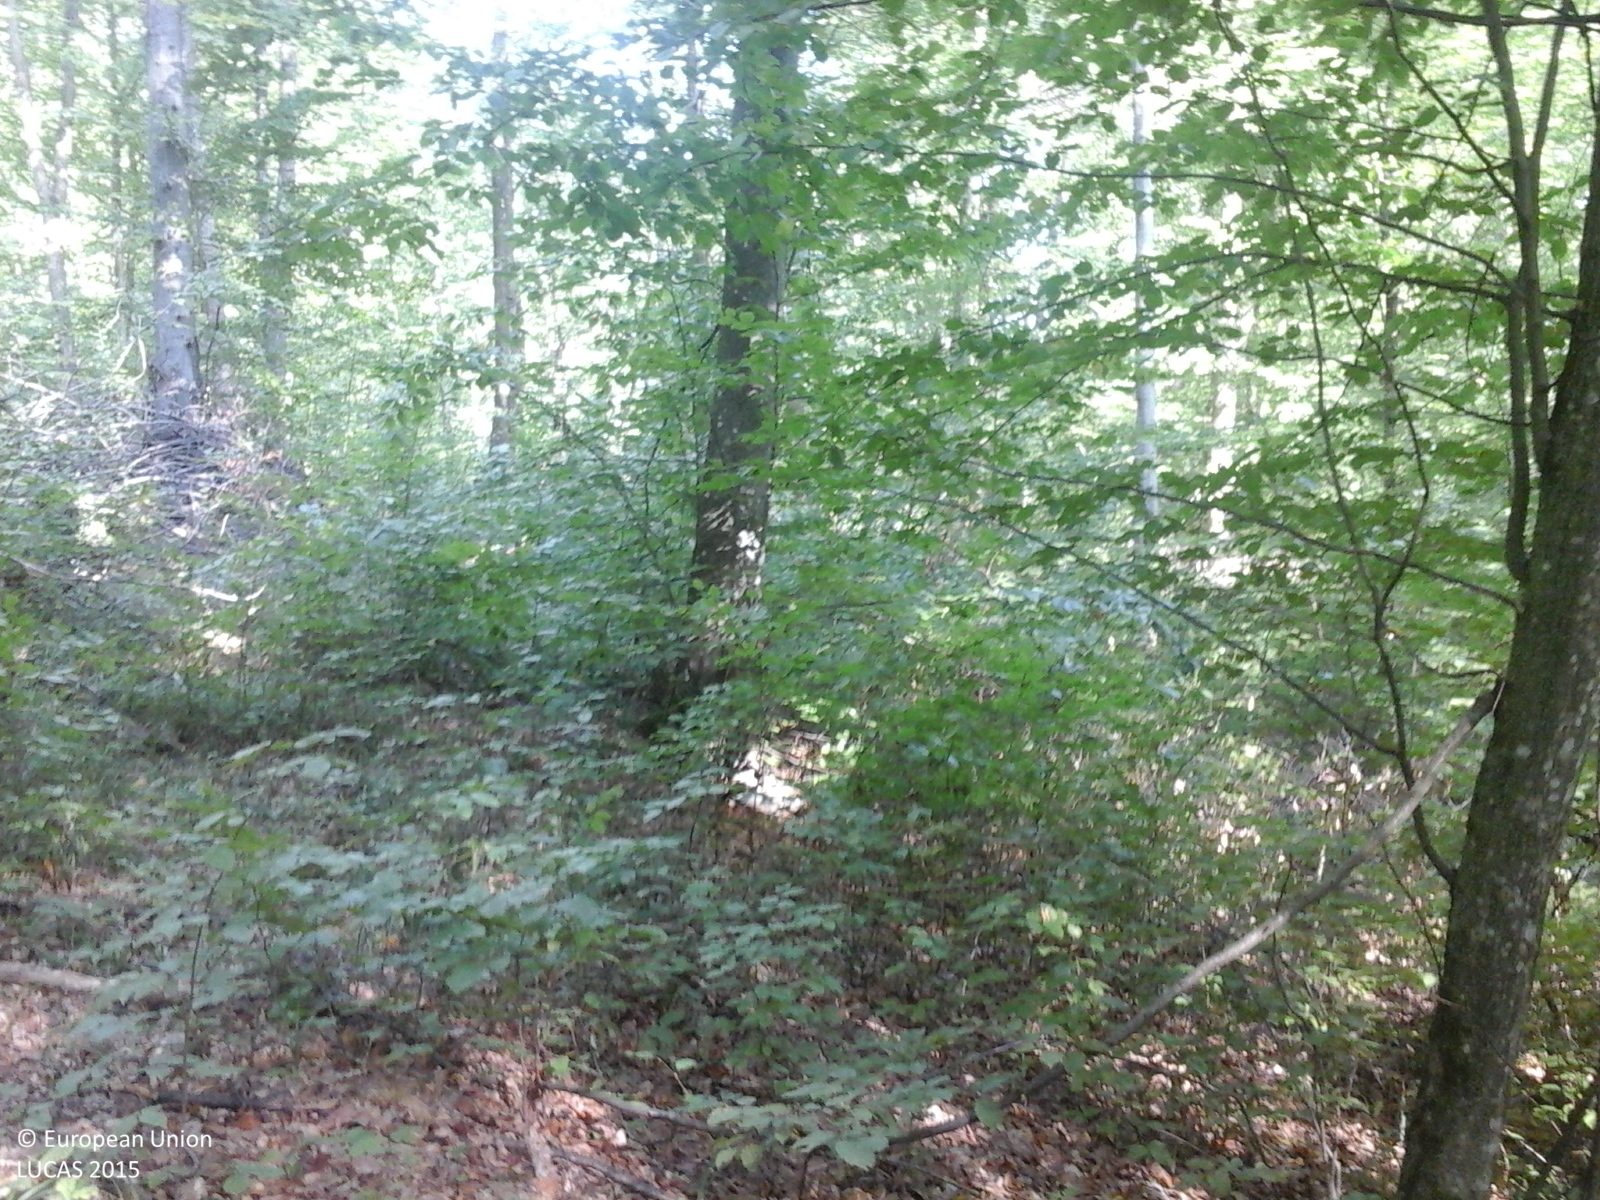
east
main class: Woodland
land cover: Broadleaved woodland
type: mesophytic deciduous forest
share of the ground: > 75 %
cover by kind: broadleaved forest trees 100 %
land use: Forestry
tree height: > 5 m
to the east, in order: Broadleaved woodland; Tracks; Broadleaved woodland; Tracks; Broadleaved woodland; Shrubland with sparse tree cover; Tracks; Grassland with sparse tree/shrub cover
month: September
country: RO
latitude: 47.2548
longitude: 23.8343
